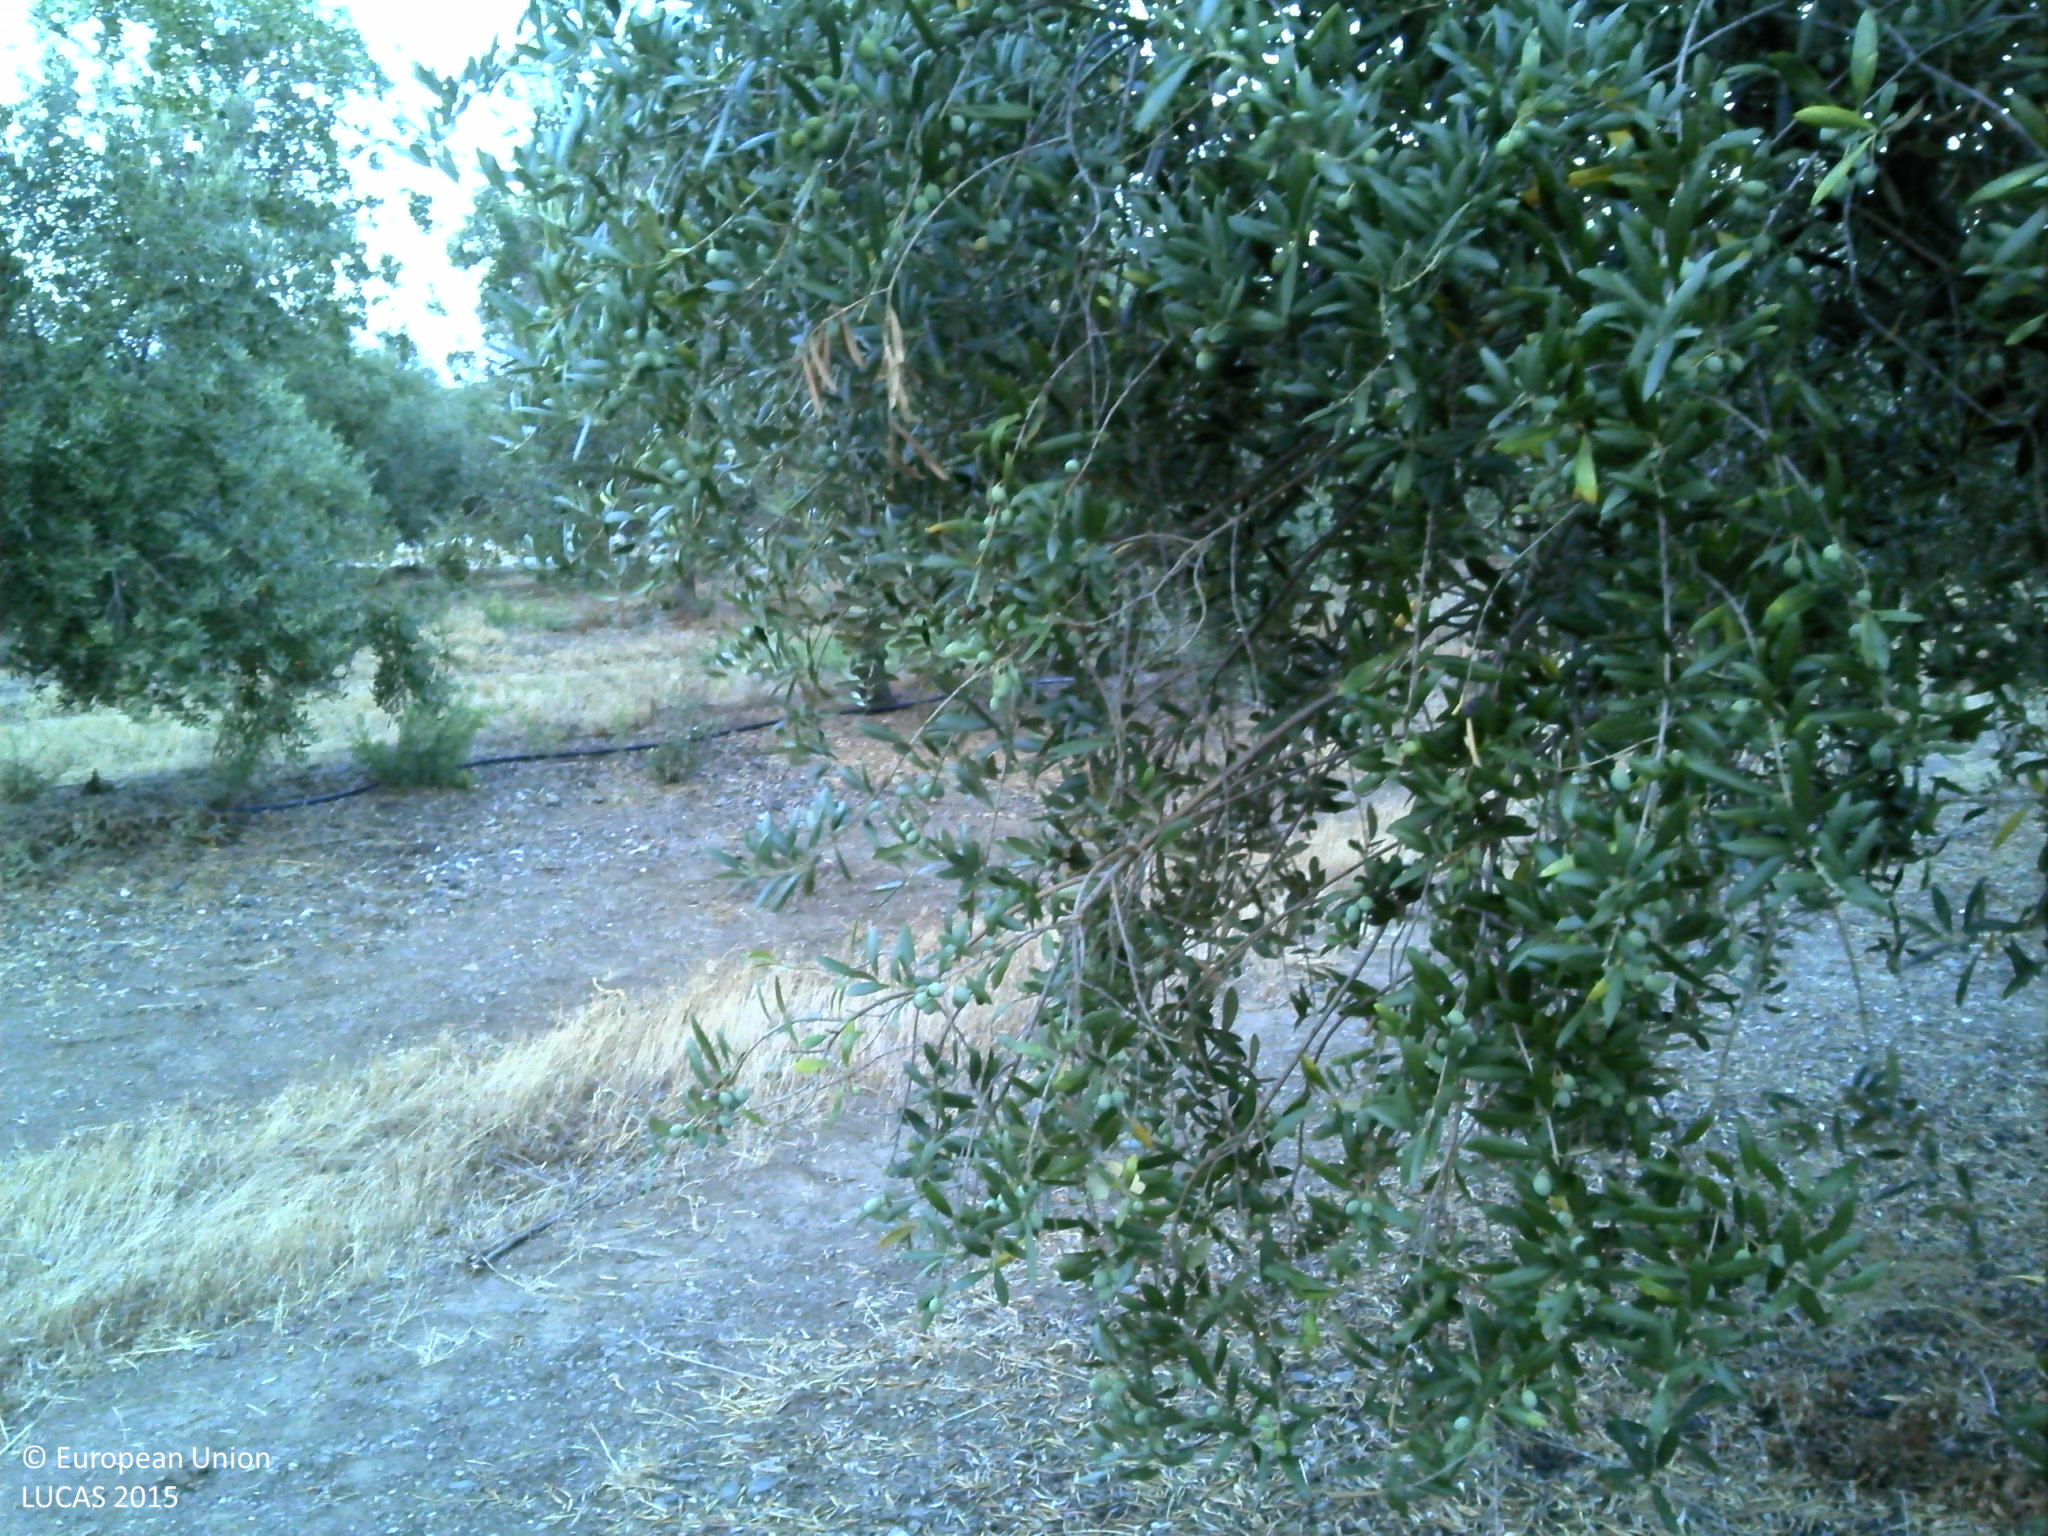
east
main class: Cropland
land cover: Olive groves
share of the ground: > 75 %
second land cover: Grassland without tree/shrub cover
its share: < 10 %
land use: Agriculture (excluding fallow land and kitchen gardens)
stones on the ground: < 10 %
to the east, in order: Olive groves; Grassland without tree/shrub cover; Olive groves; Other bare soil; Grass margins; Tracks; Grass margins; Tracks; Electric lines; Olive groves; Tracks; Olive groves
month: July
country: PT
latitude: 38.0832
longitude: -7.7315
